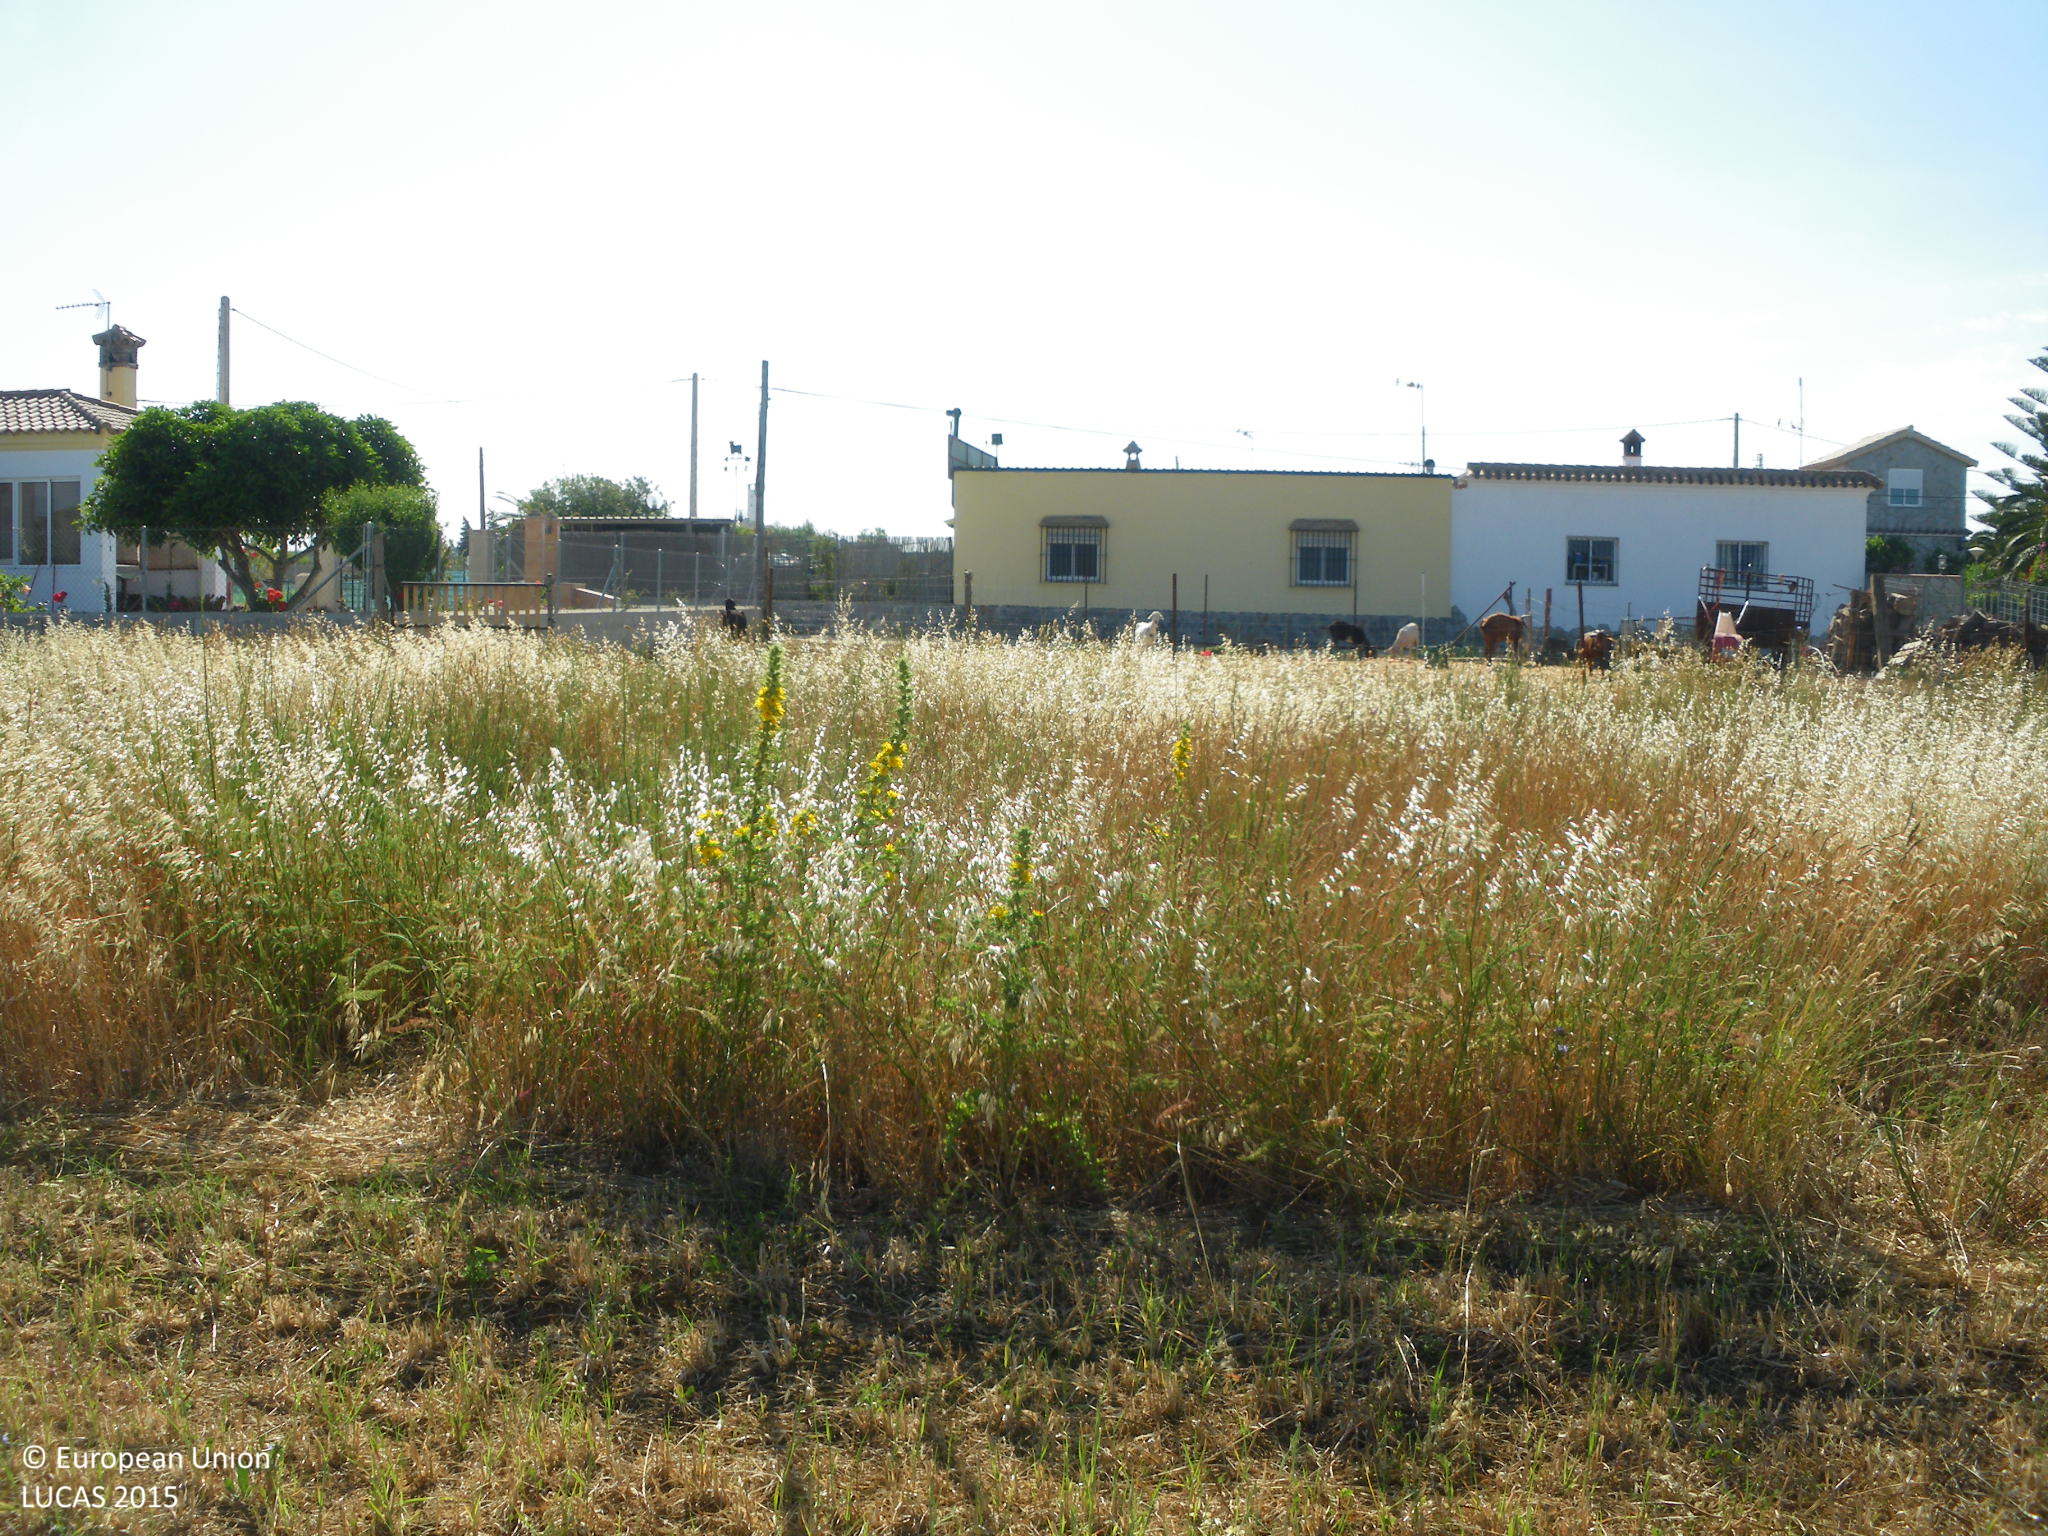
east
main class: Grassland
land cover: Spontaneously vegetated surfaces
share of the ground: > 75 %
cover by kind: herbaceous plants 85 %, unconsolidated bare surface 15 %
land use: Fallow land
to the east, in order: Spontaneously vegetated surfaces; Grassland without tree/shrub cover; Fences; Grassland without tree/shrub cover; Fences; Artificial constructions in urban areas; Oats; Electric lines; Oats; Fences; Artificial constructions in urban areas
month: May
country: ES
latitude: 36.3250
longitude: -6.1233
